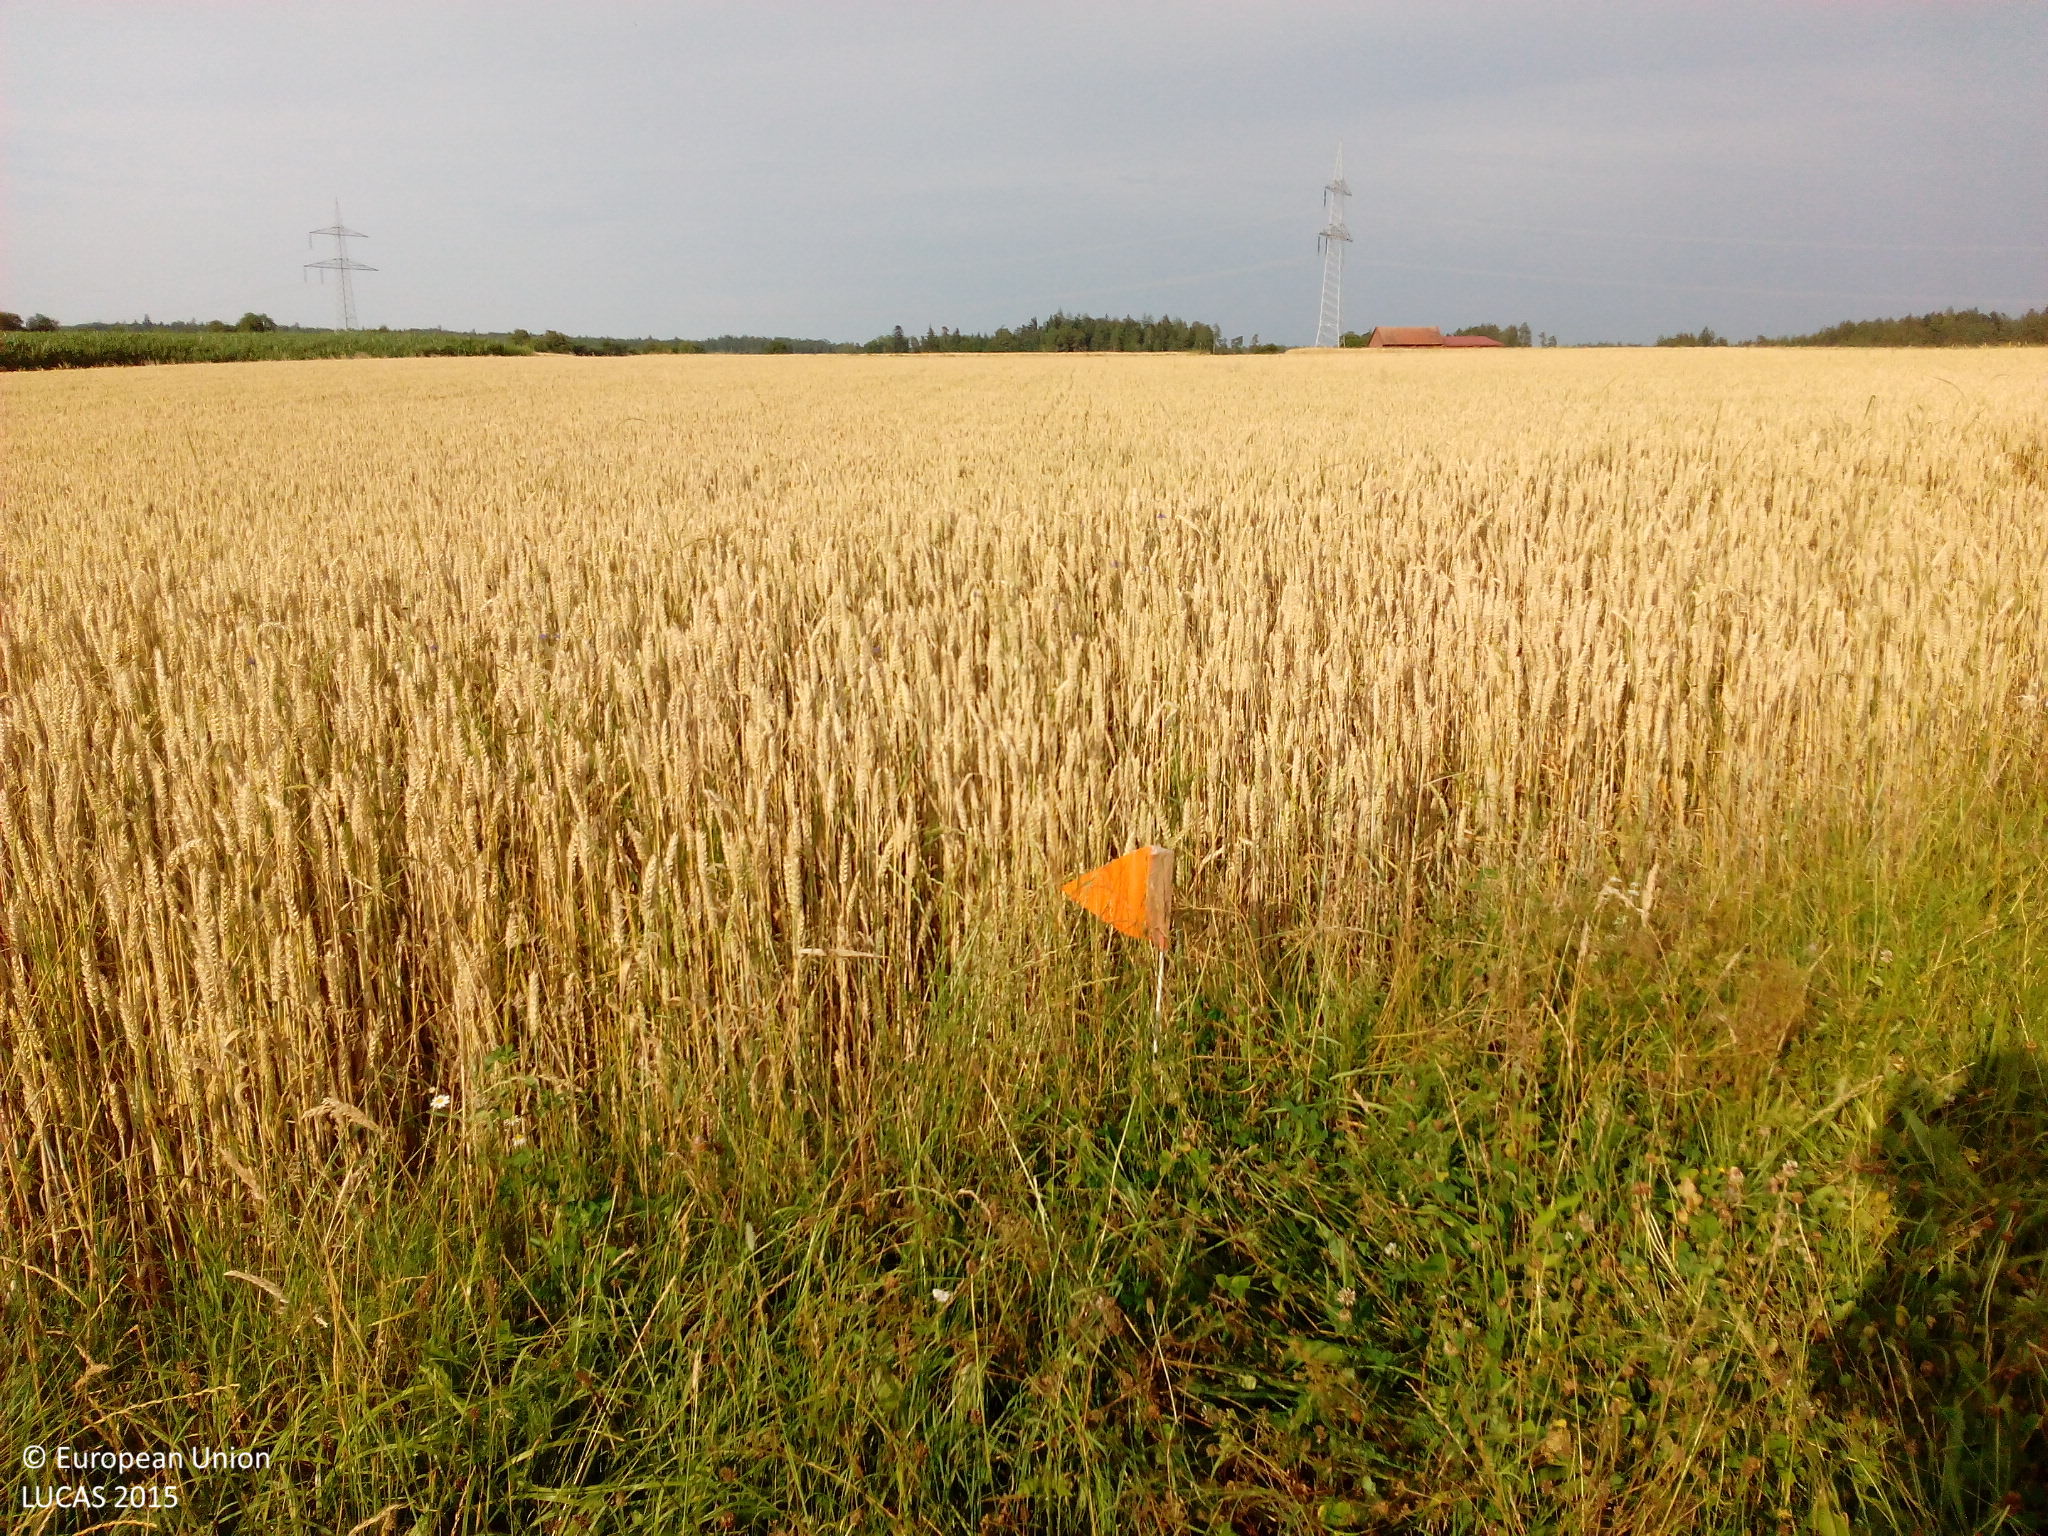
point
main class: Cropland
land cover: Common wheat
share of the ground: > 75 %
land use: Agriculture (excluding fallow land and kitchen gardens)
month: July
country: DE
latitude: 49.0332
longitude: 9.9590
